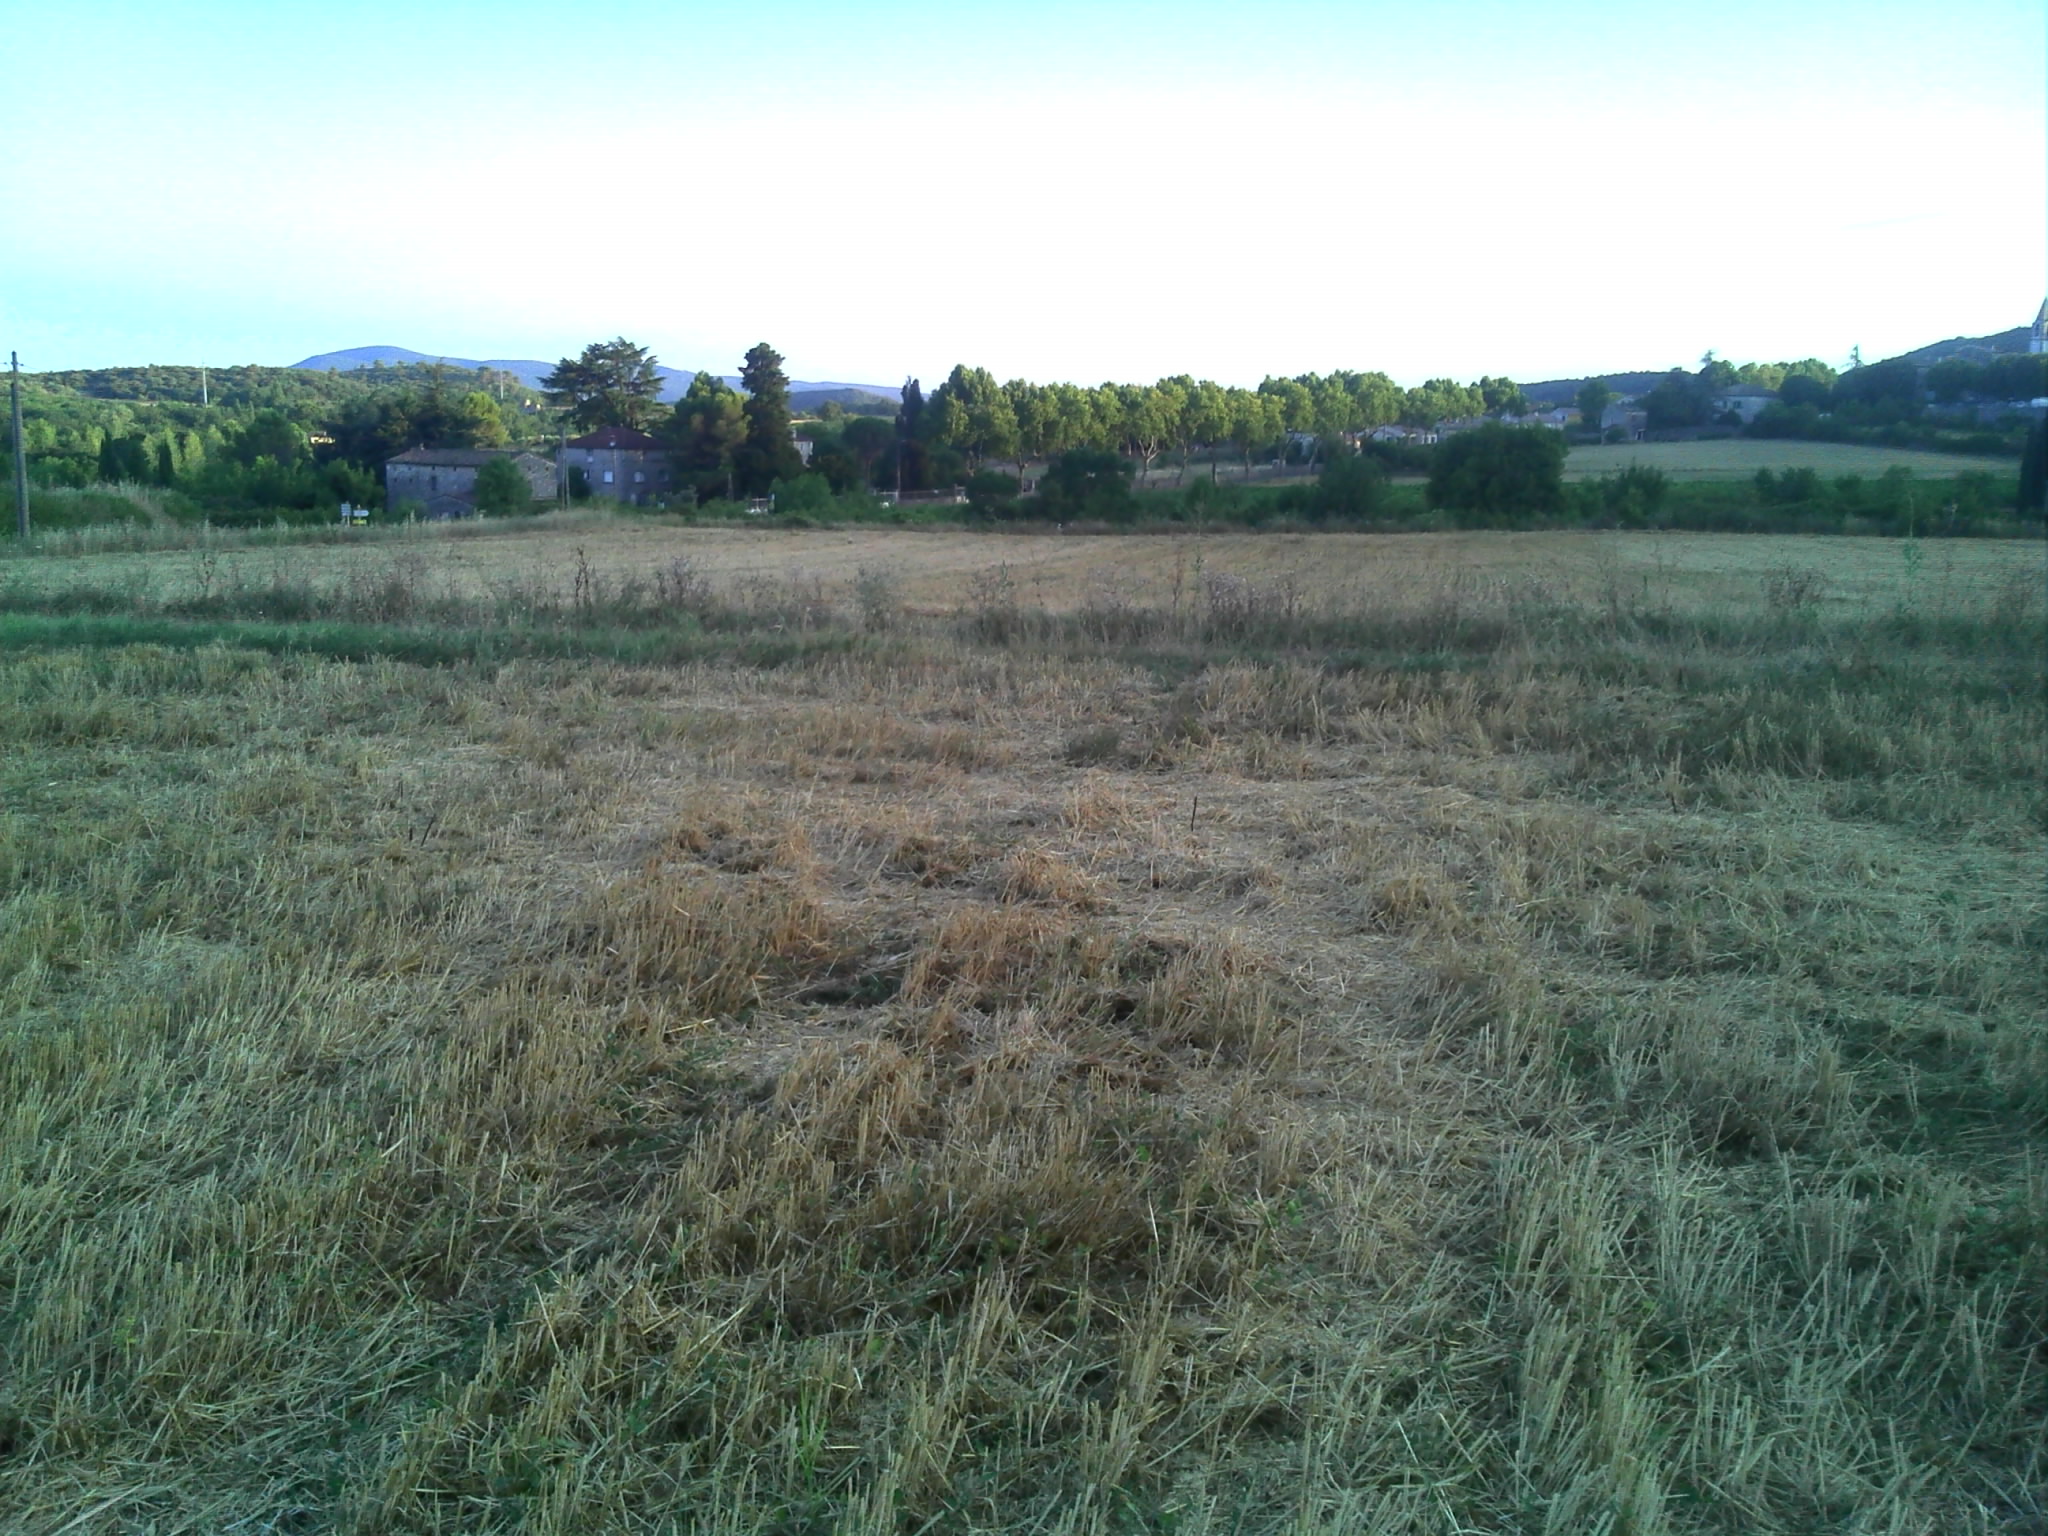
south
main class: Cropland
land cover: Common wheat
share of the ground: 10 - 25 %
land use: Agriculture (excluding fallow land and kitchen gardens)
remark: Harvested field
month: July
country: FR
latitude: 43.9938
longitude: 3.9601
